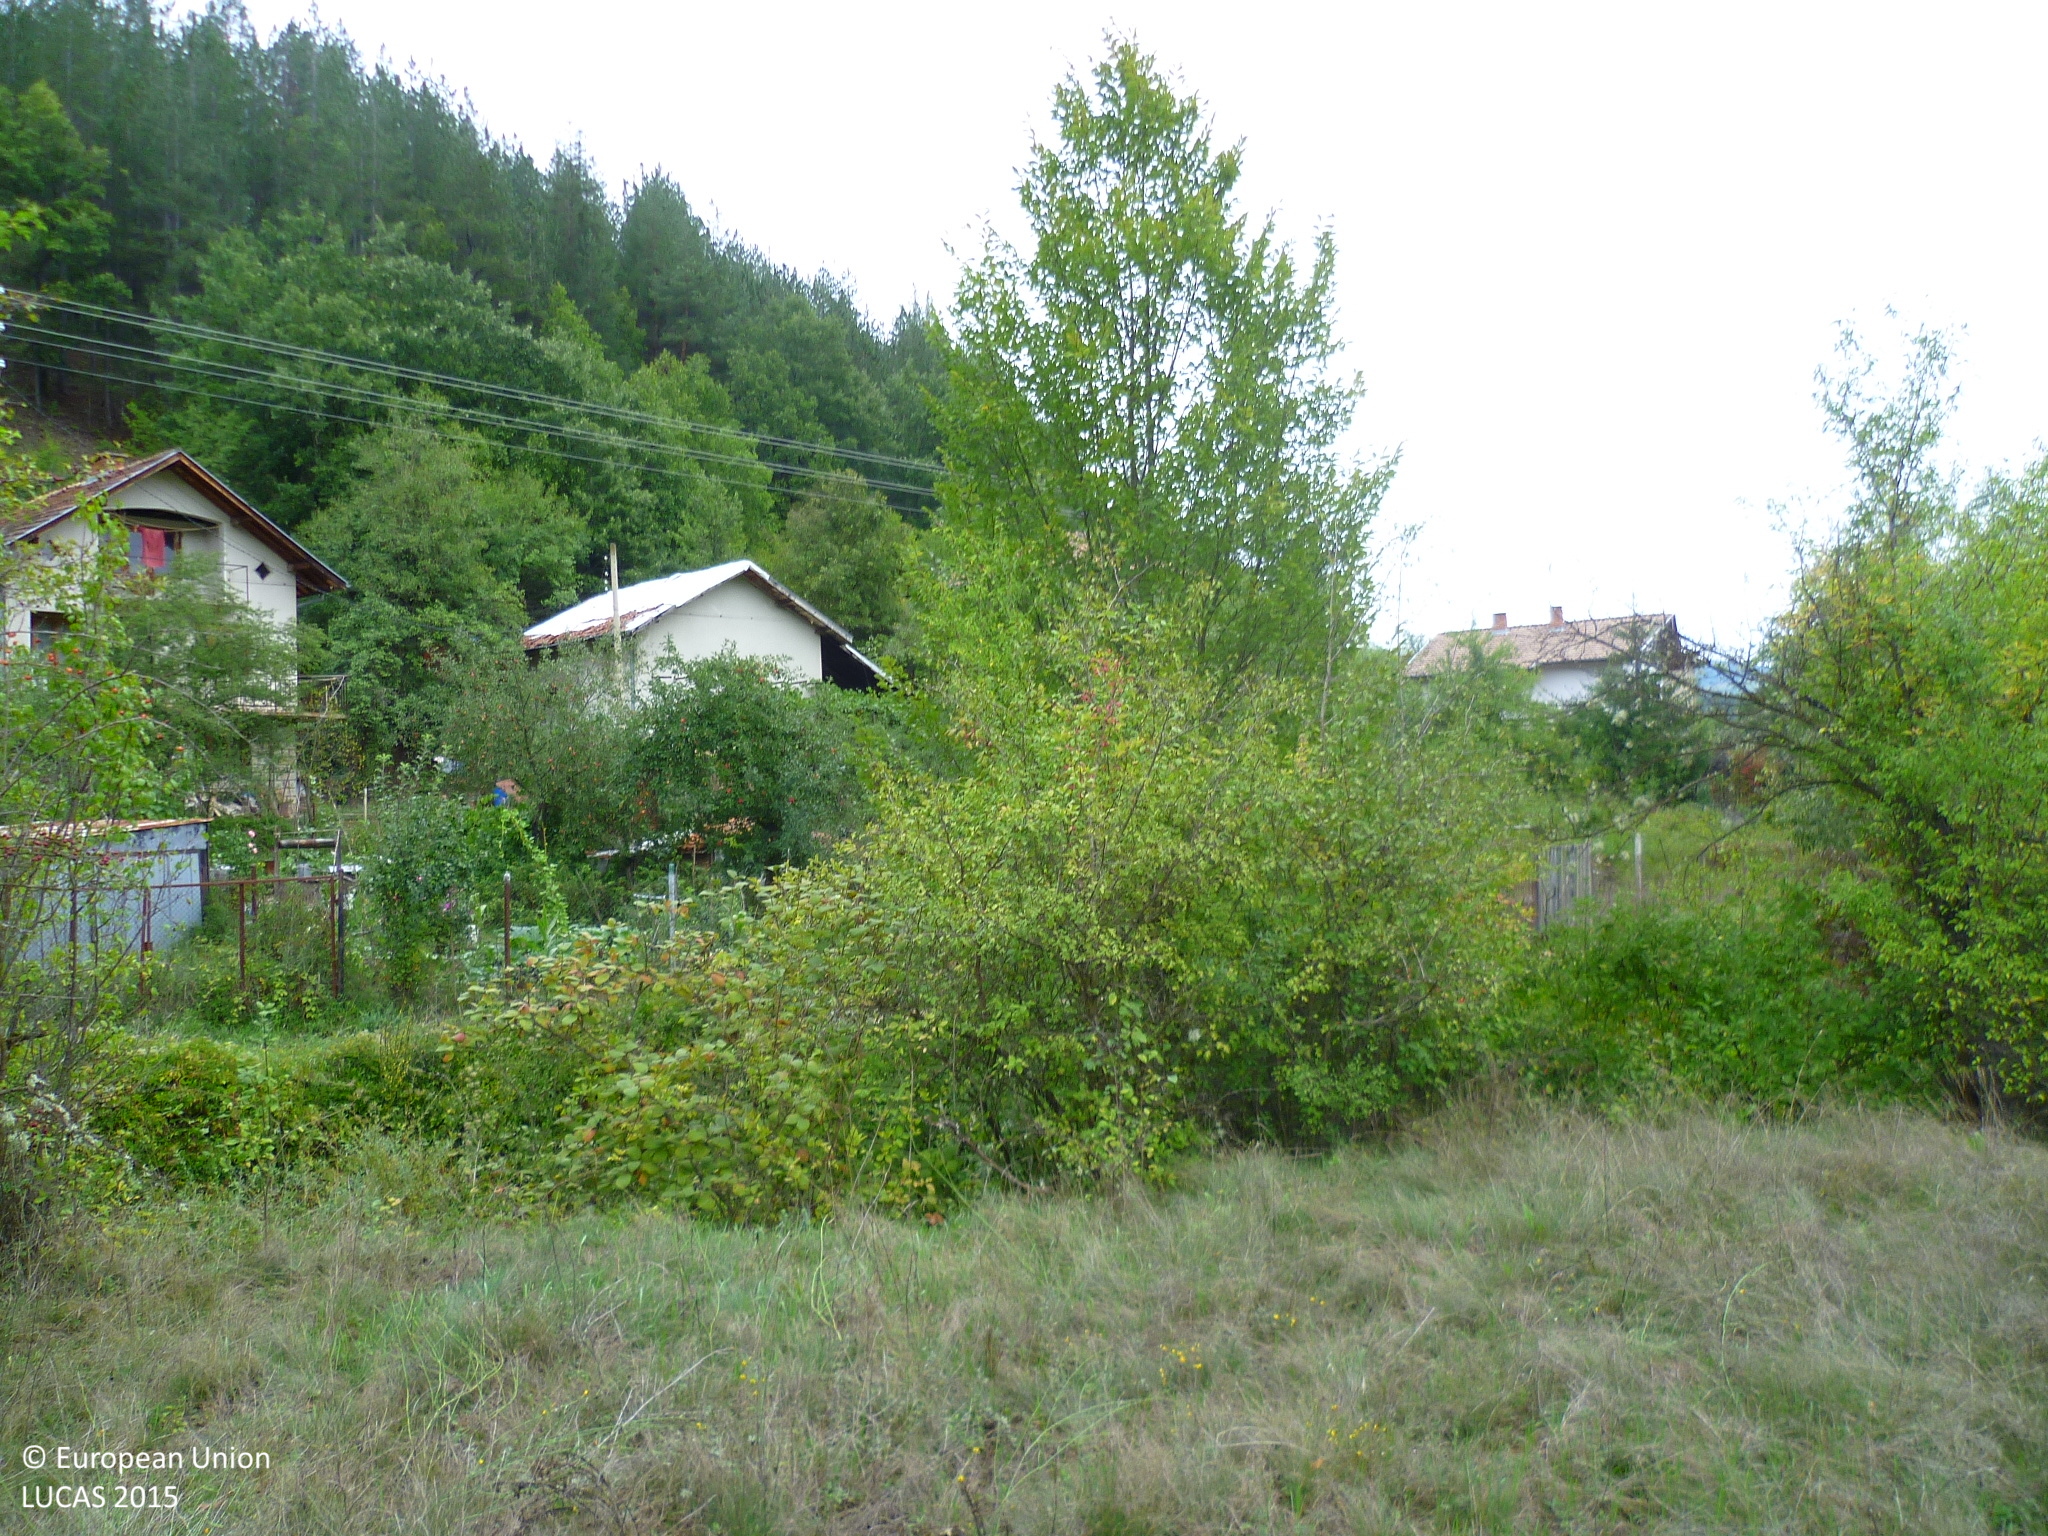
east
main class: Grassland
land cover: Grassland with sparse tree/shrub cover
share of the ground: > 75 %
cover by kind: herbaceous plants 90 %, broadleaved forest trees 5 %, shrubs 5 %
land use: Agriculture (excluding fallow land and kitchen gardens)
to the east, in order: Grassland with sparse tree/shrub cover; Artificial constructions in urban areas; Broadleaved woodland
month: September
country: BG
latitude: 42.5833
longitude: 22.6844
